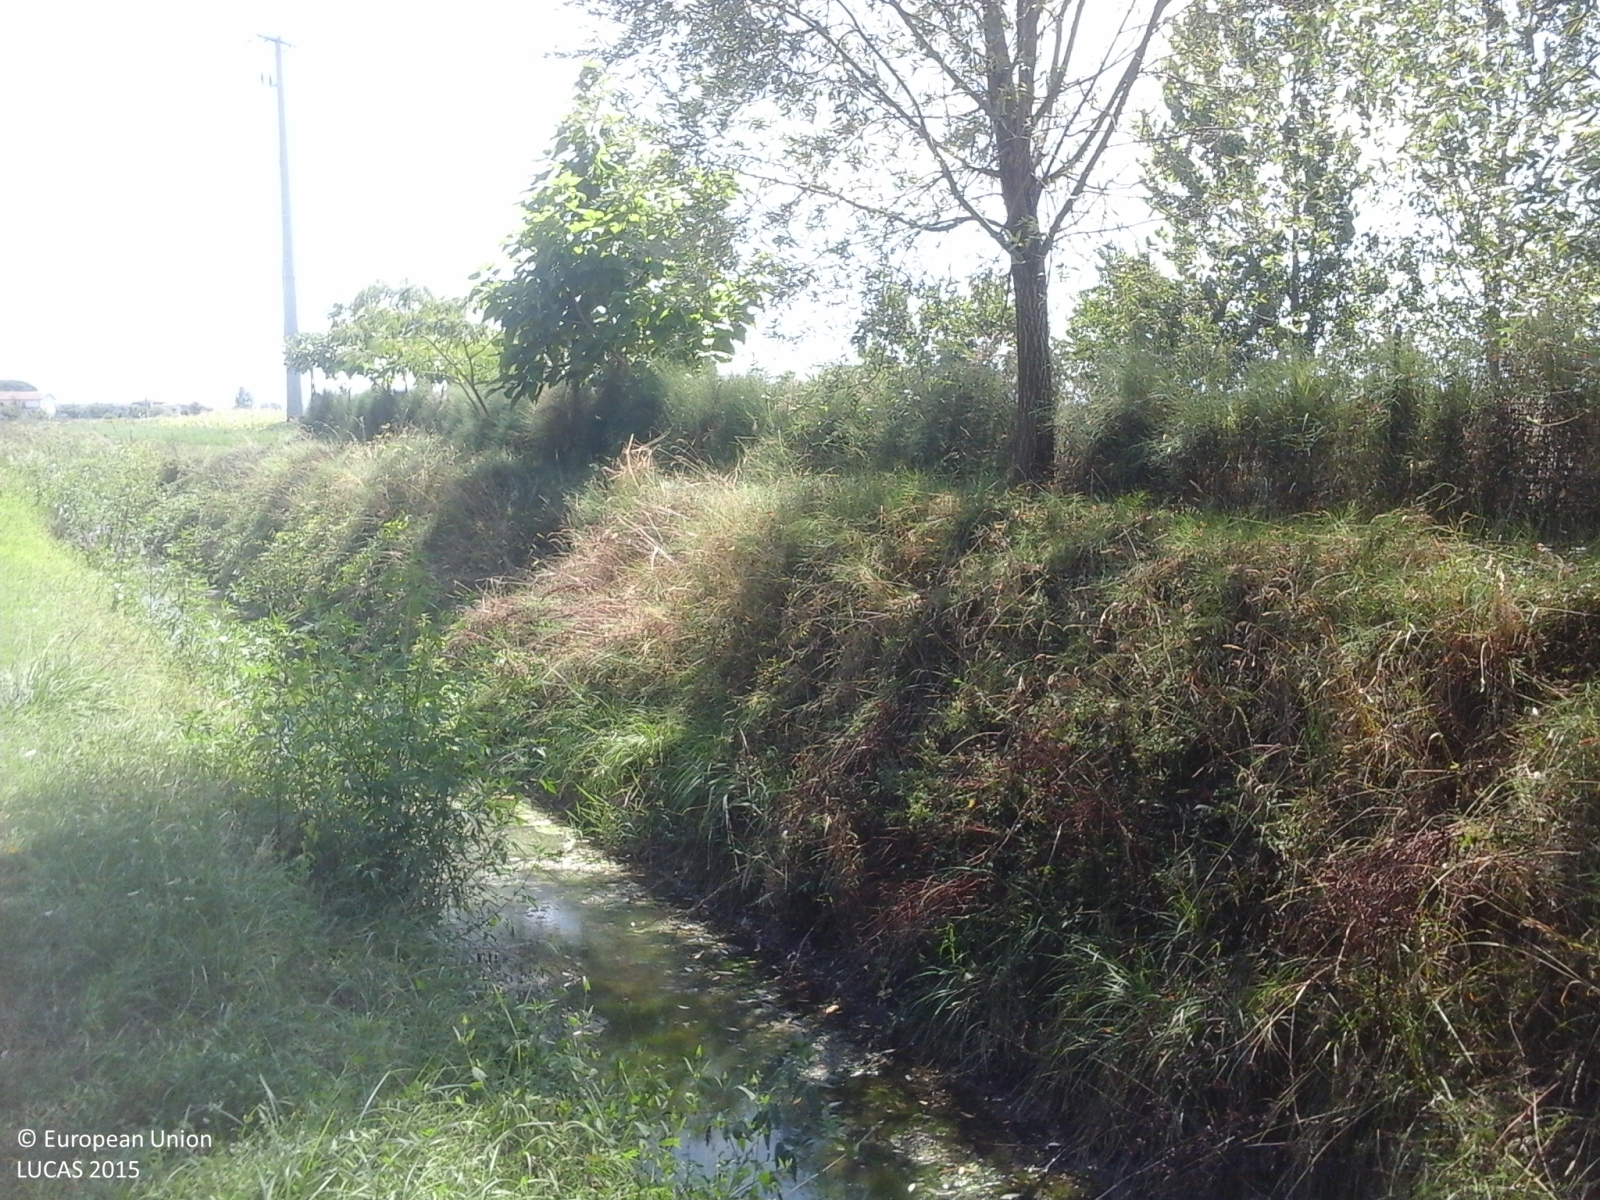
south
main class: Grassland
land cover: Grassland without tree/shrub cover
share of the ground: > 75 %
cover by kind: herbaceous plants 100 %
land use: Residential
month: August
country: IT
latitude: 43.8605
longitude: 10.7818
